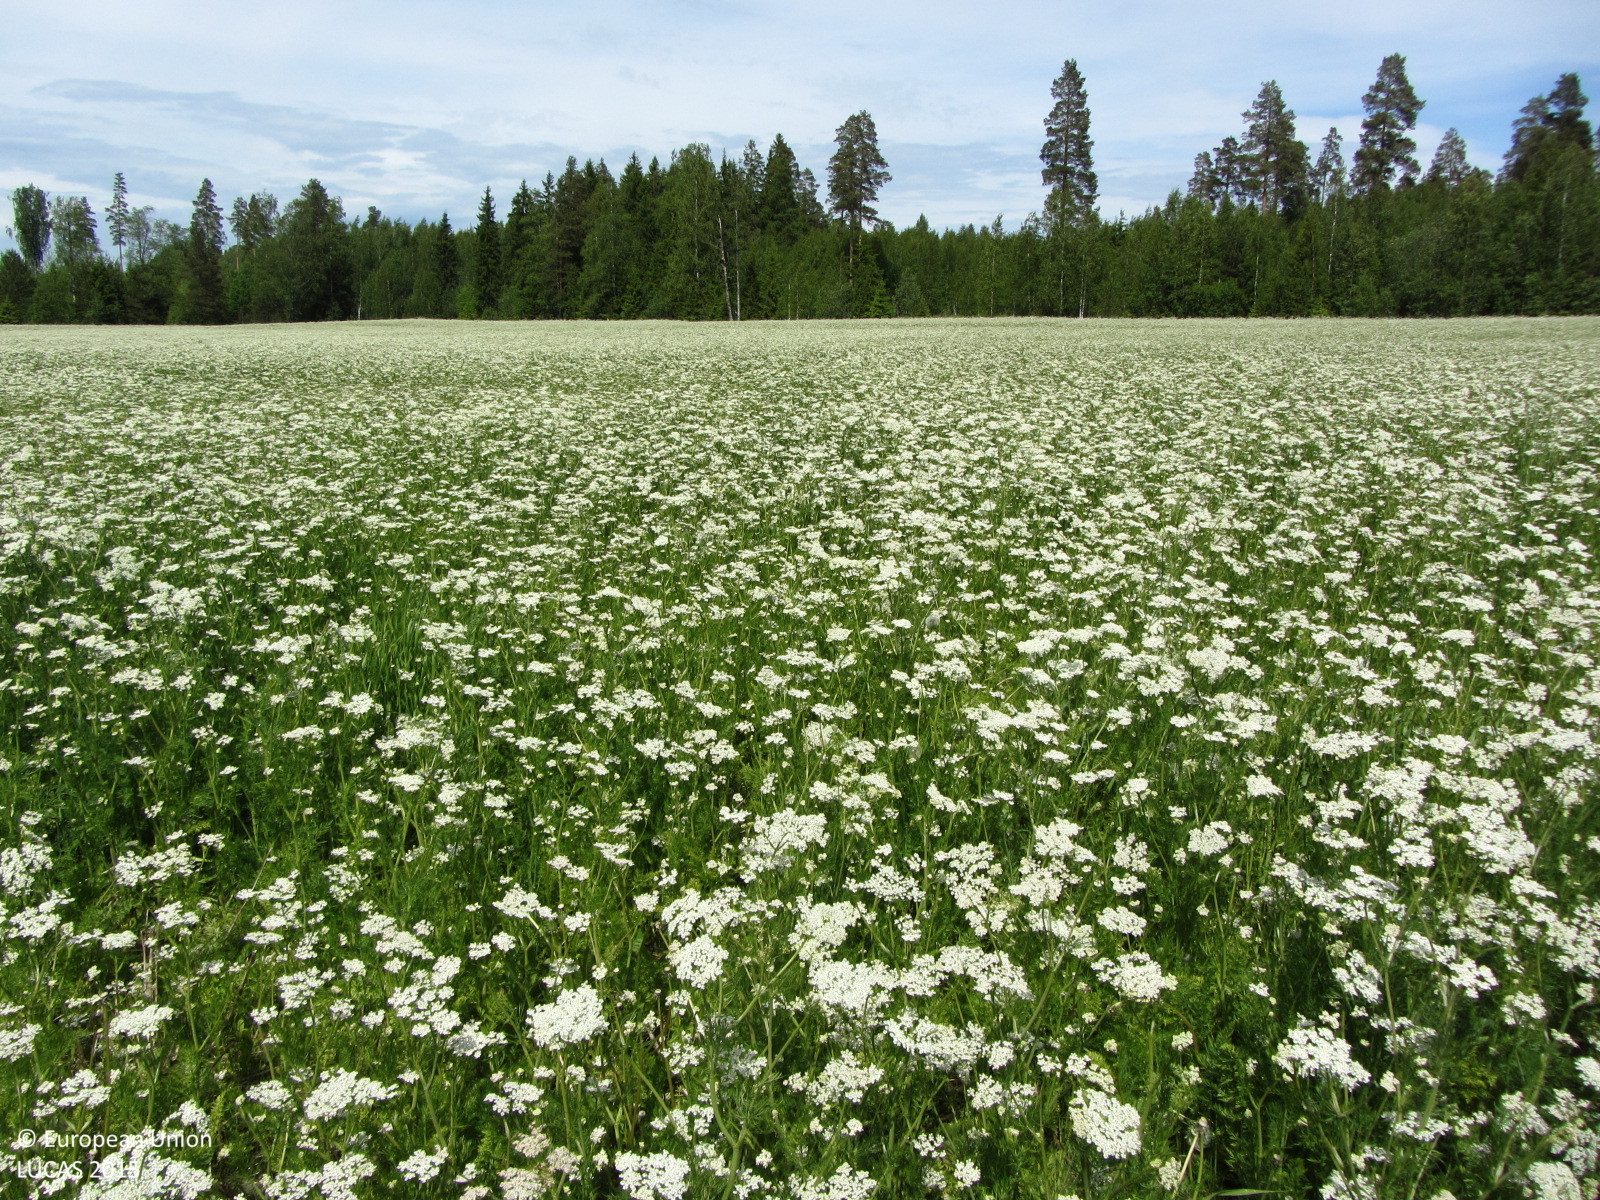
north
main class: Cropland
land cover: Other non-permanent industrial crops
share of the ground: > 75 %
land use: Agriculture (excluding fallow land and kitchen gardens)
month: June
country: FI
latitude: 60.3919
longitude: 24.3849
